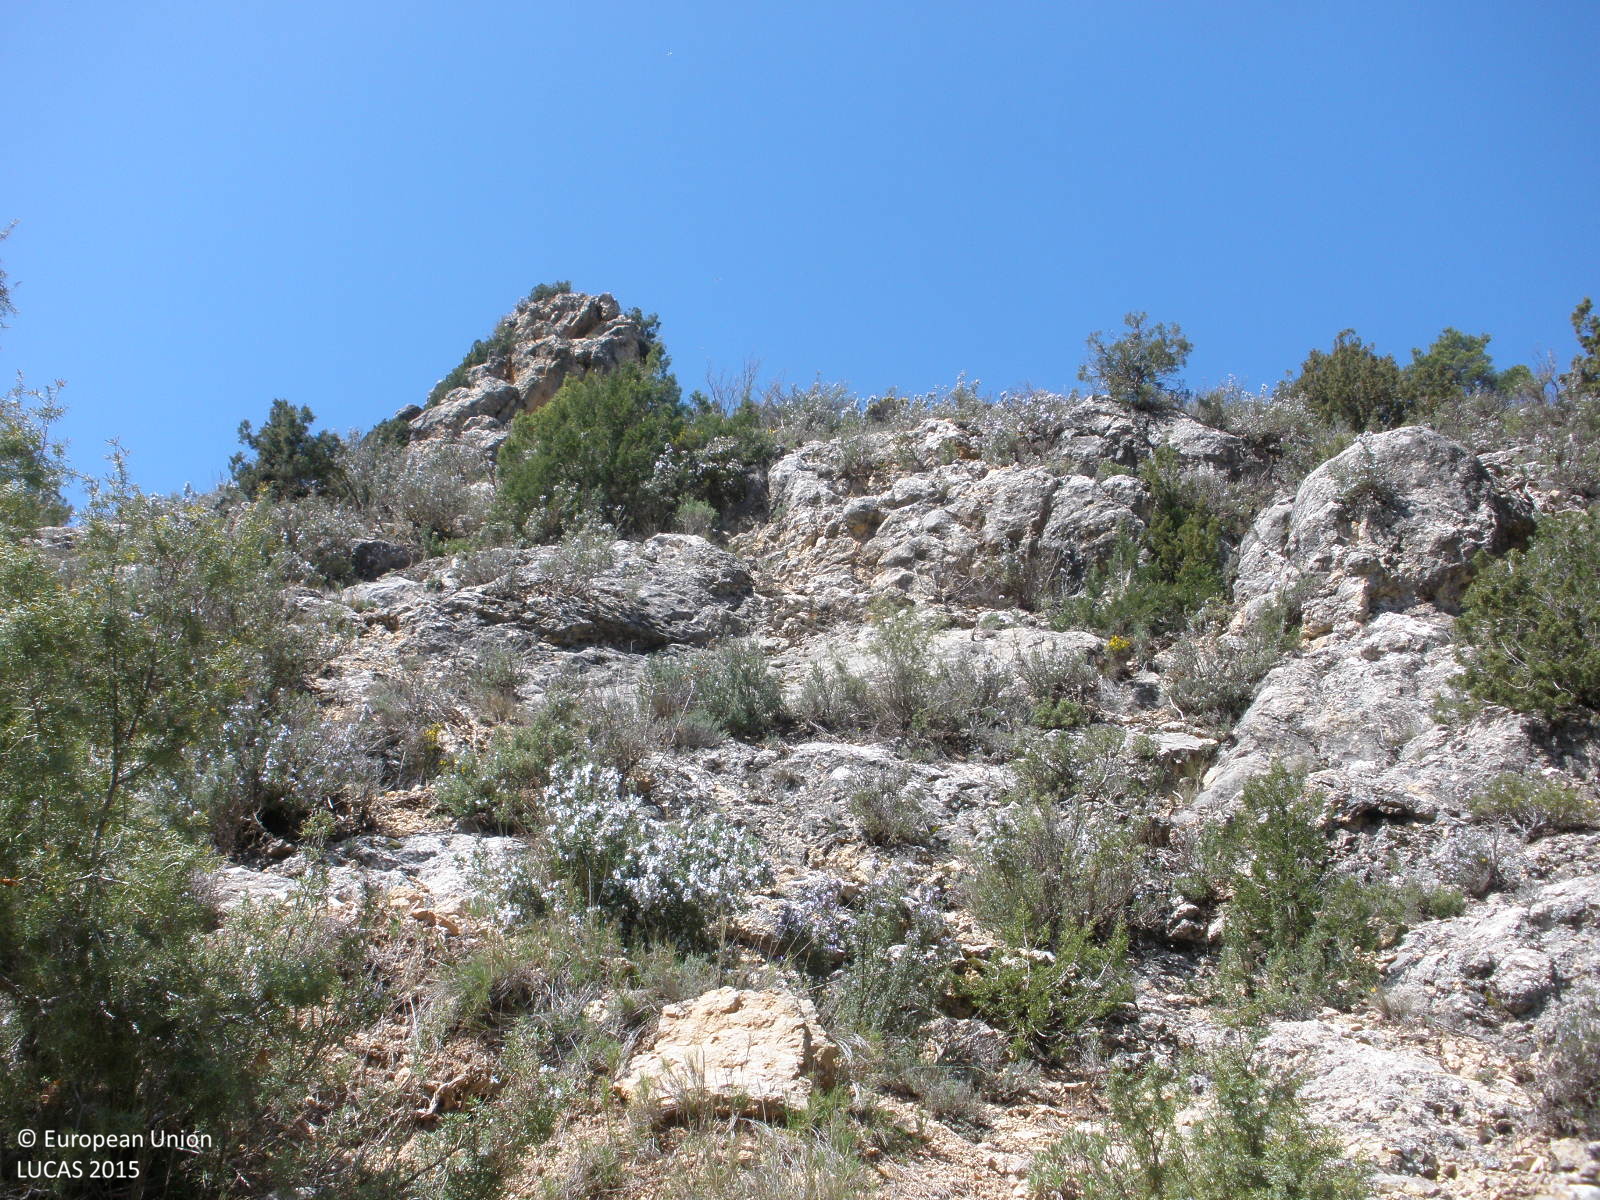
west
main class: Woodland
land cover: Pine dominated coniferous woodland
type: coniferous forest of the mediterranean region
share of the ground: 25 - 50 %
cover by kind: shrubs 45 %, consolidated bare surface 30 %, coniferous forest trees 25 %
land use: Semi-natural and natural areas not in use
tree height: > 5 m
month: April
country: ES
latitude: 40.2223
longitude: -1.2329
